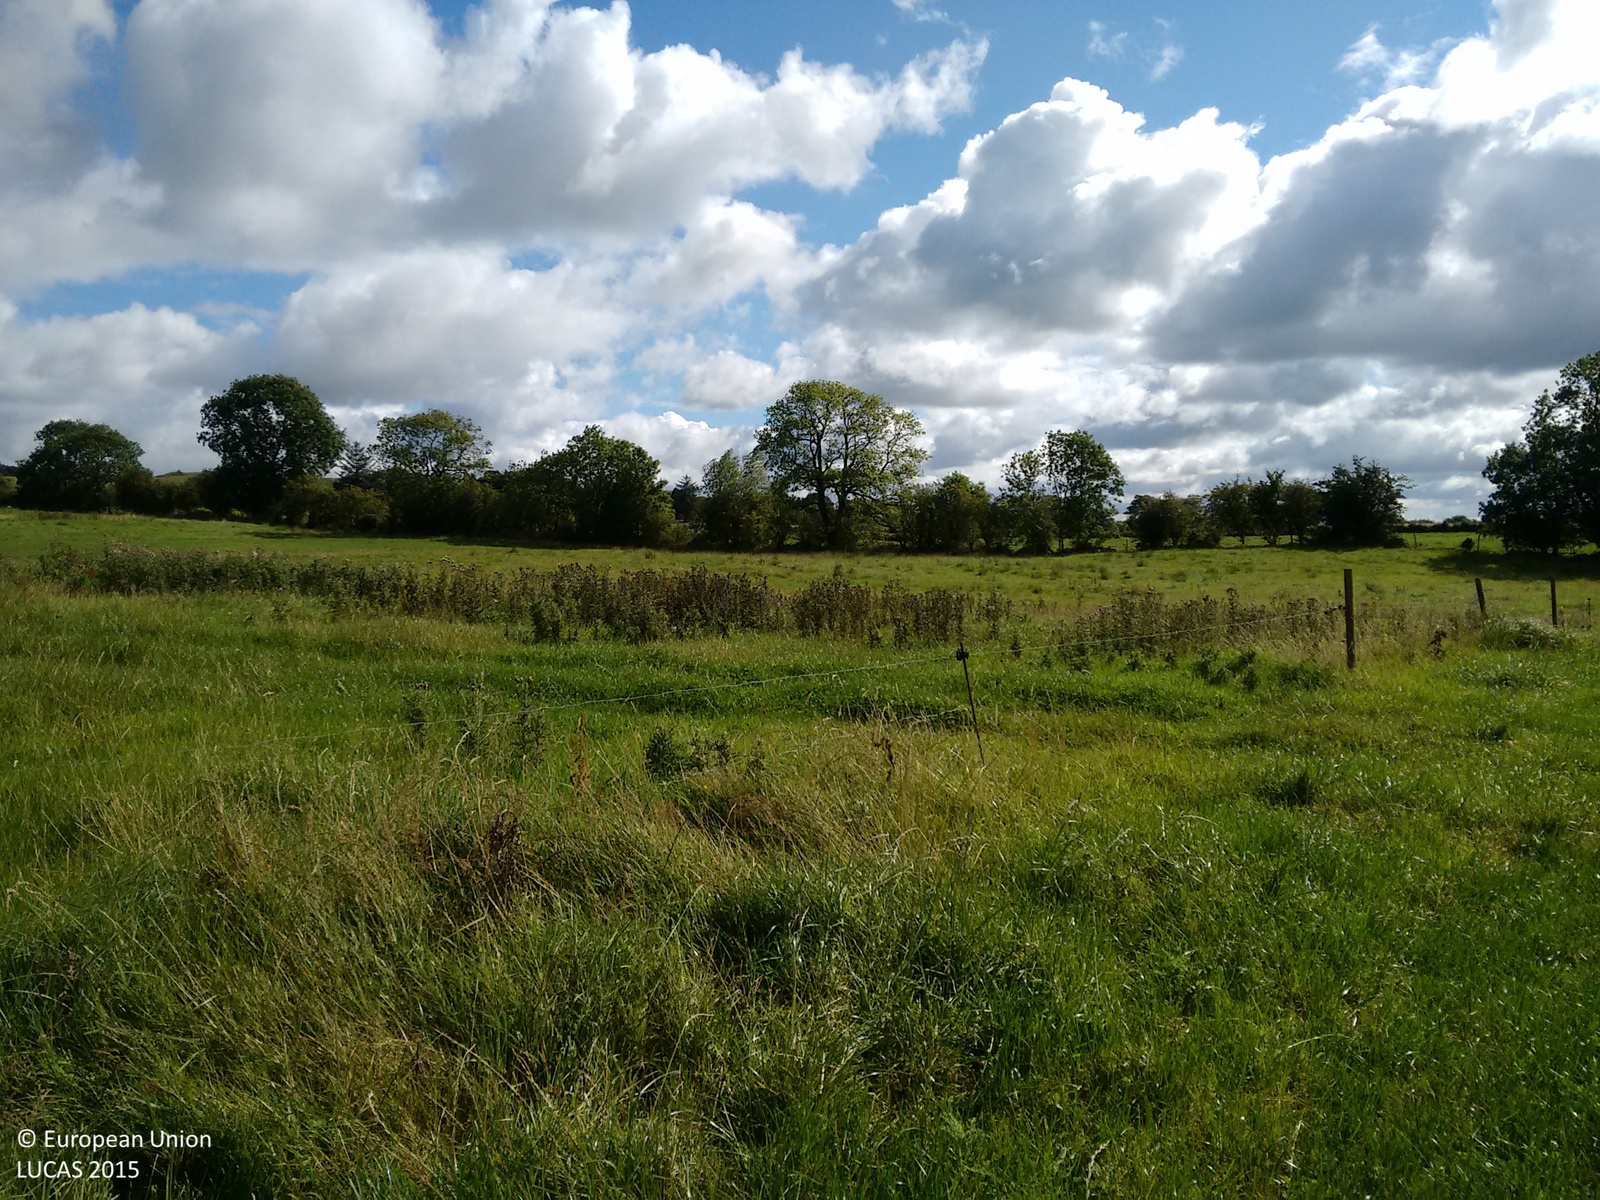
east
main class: Grassland
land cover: Grassland without tree/shrub cover
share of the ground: > 75 %
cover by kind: herbaceous plants 100 %
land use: Agriculture (excluding fallow land and kitchen gardens)
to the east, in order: Grassland without tree/shrub cover; Fences; Grassland without tree/shrub cover; Managed hedges; Grassland without tree/shrub cover; Fences; Grassland without tree/shrub cover; Managed hedges
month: September
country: IE
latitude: 53.7400
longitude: -7.0790
